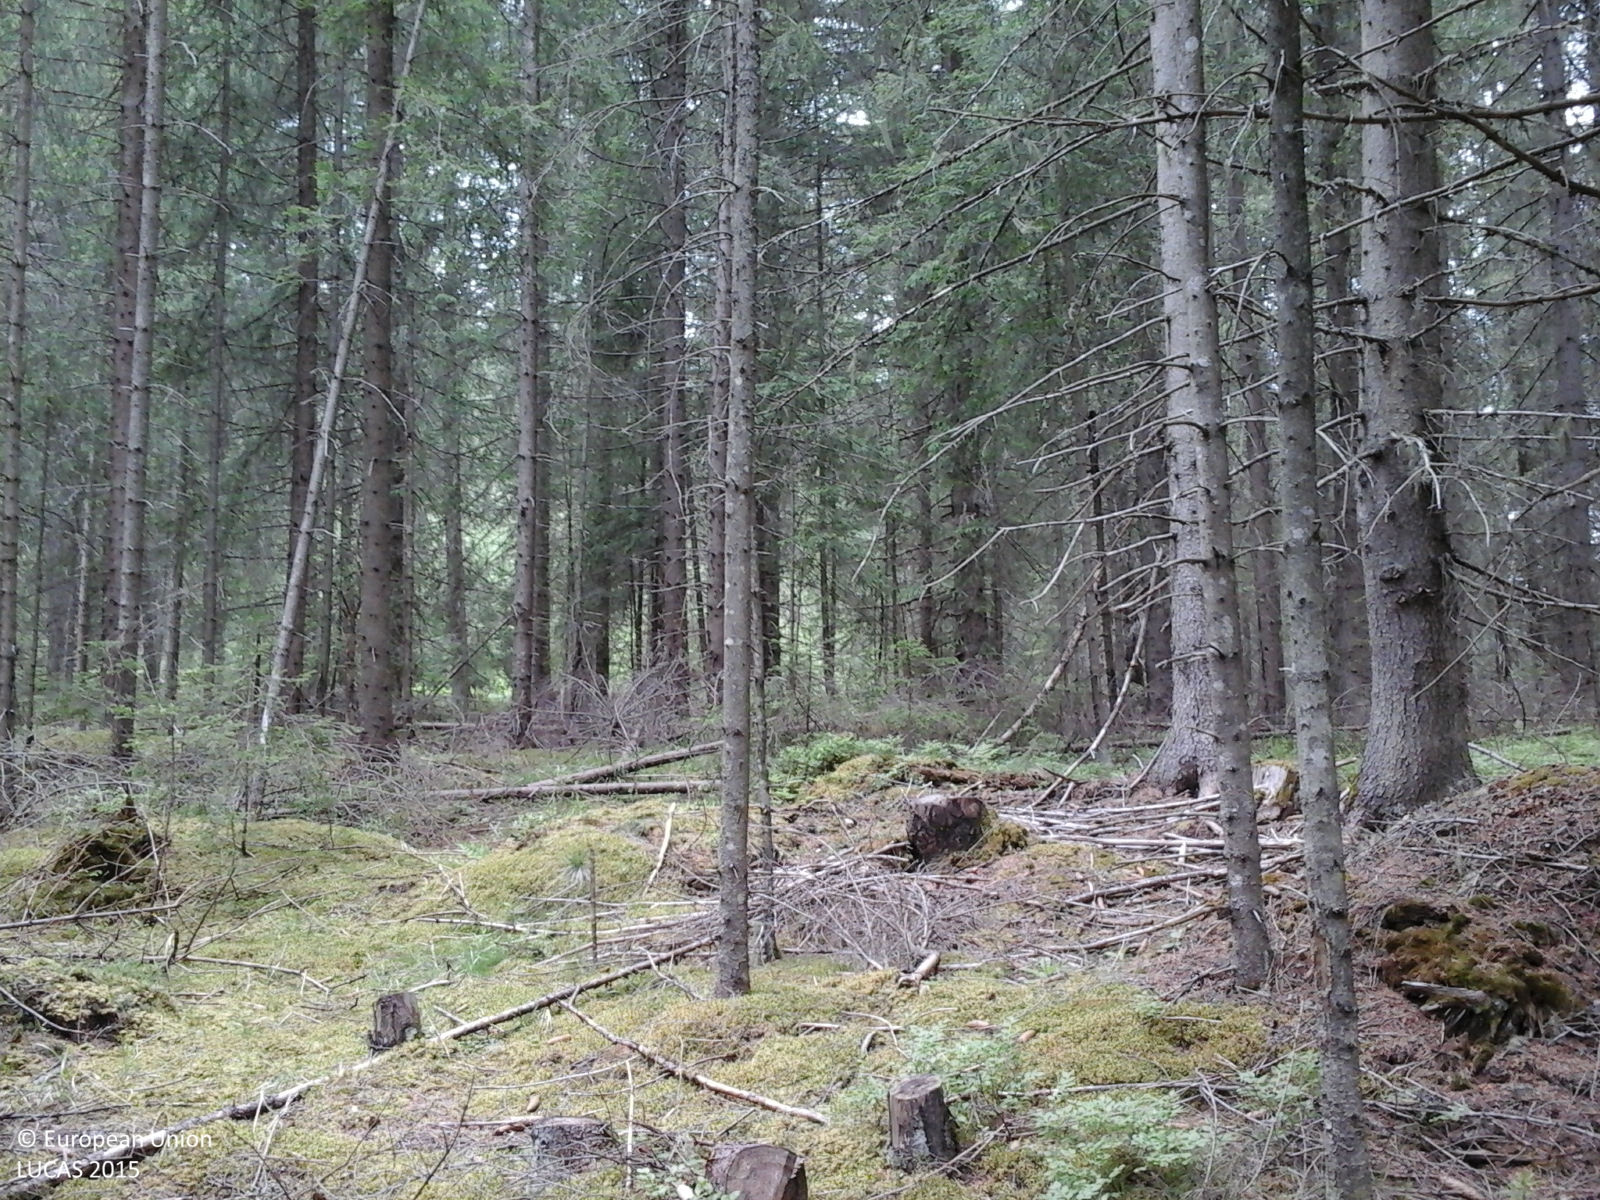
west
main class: Woodland
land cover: Spruce dominated coniferous woodland
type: alpine coniferous forest
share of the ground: > 75 %
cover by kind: coniferous forest trees 100 %
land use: Forestry
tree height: > 5 m
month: June
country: RO
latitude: 47.1480
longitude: 25.4225
